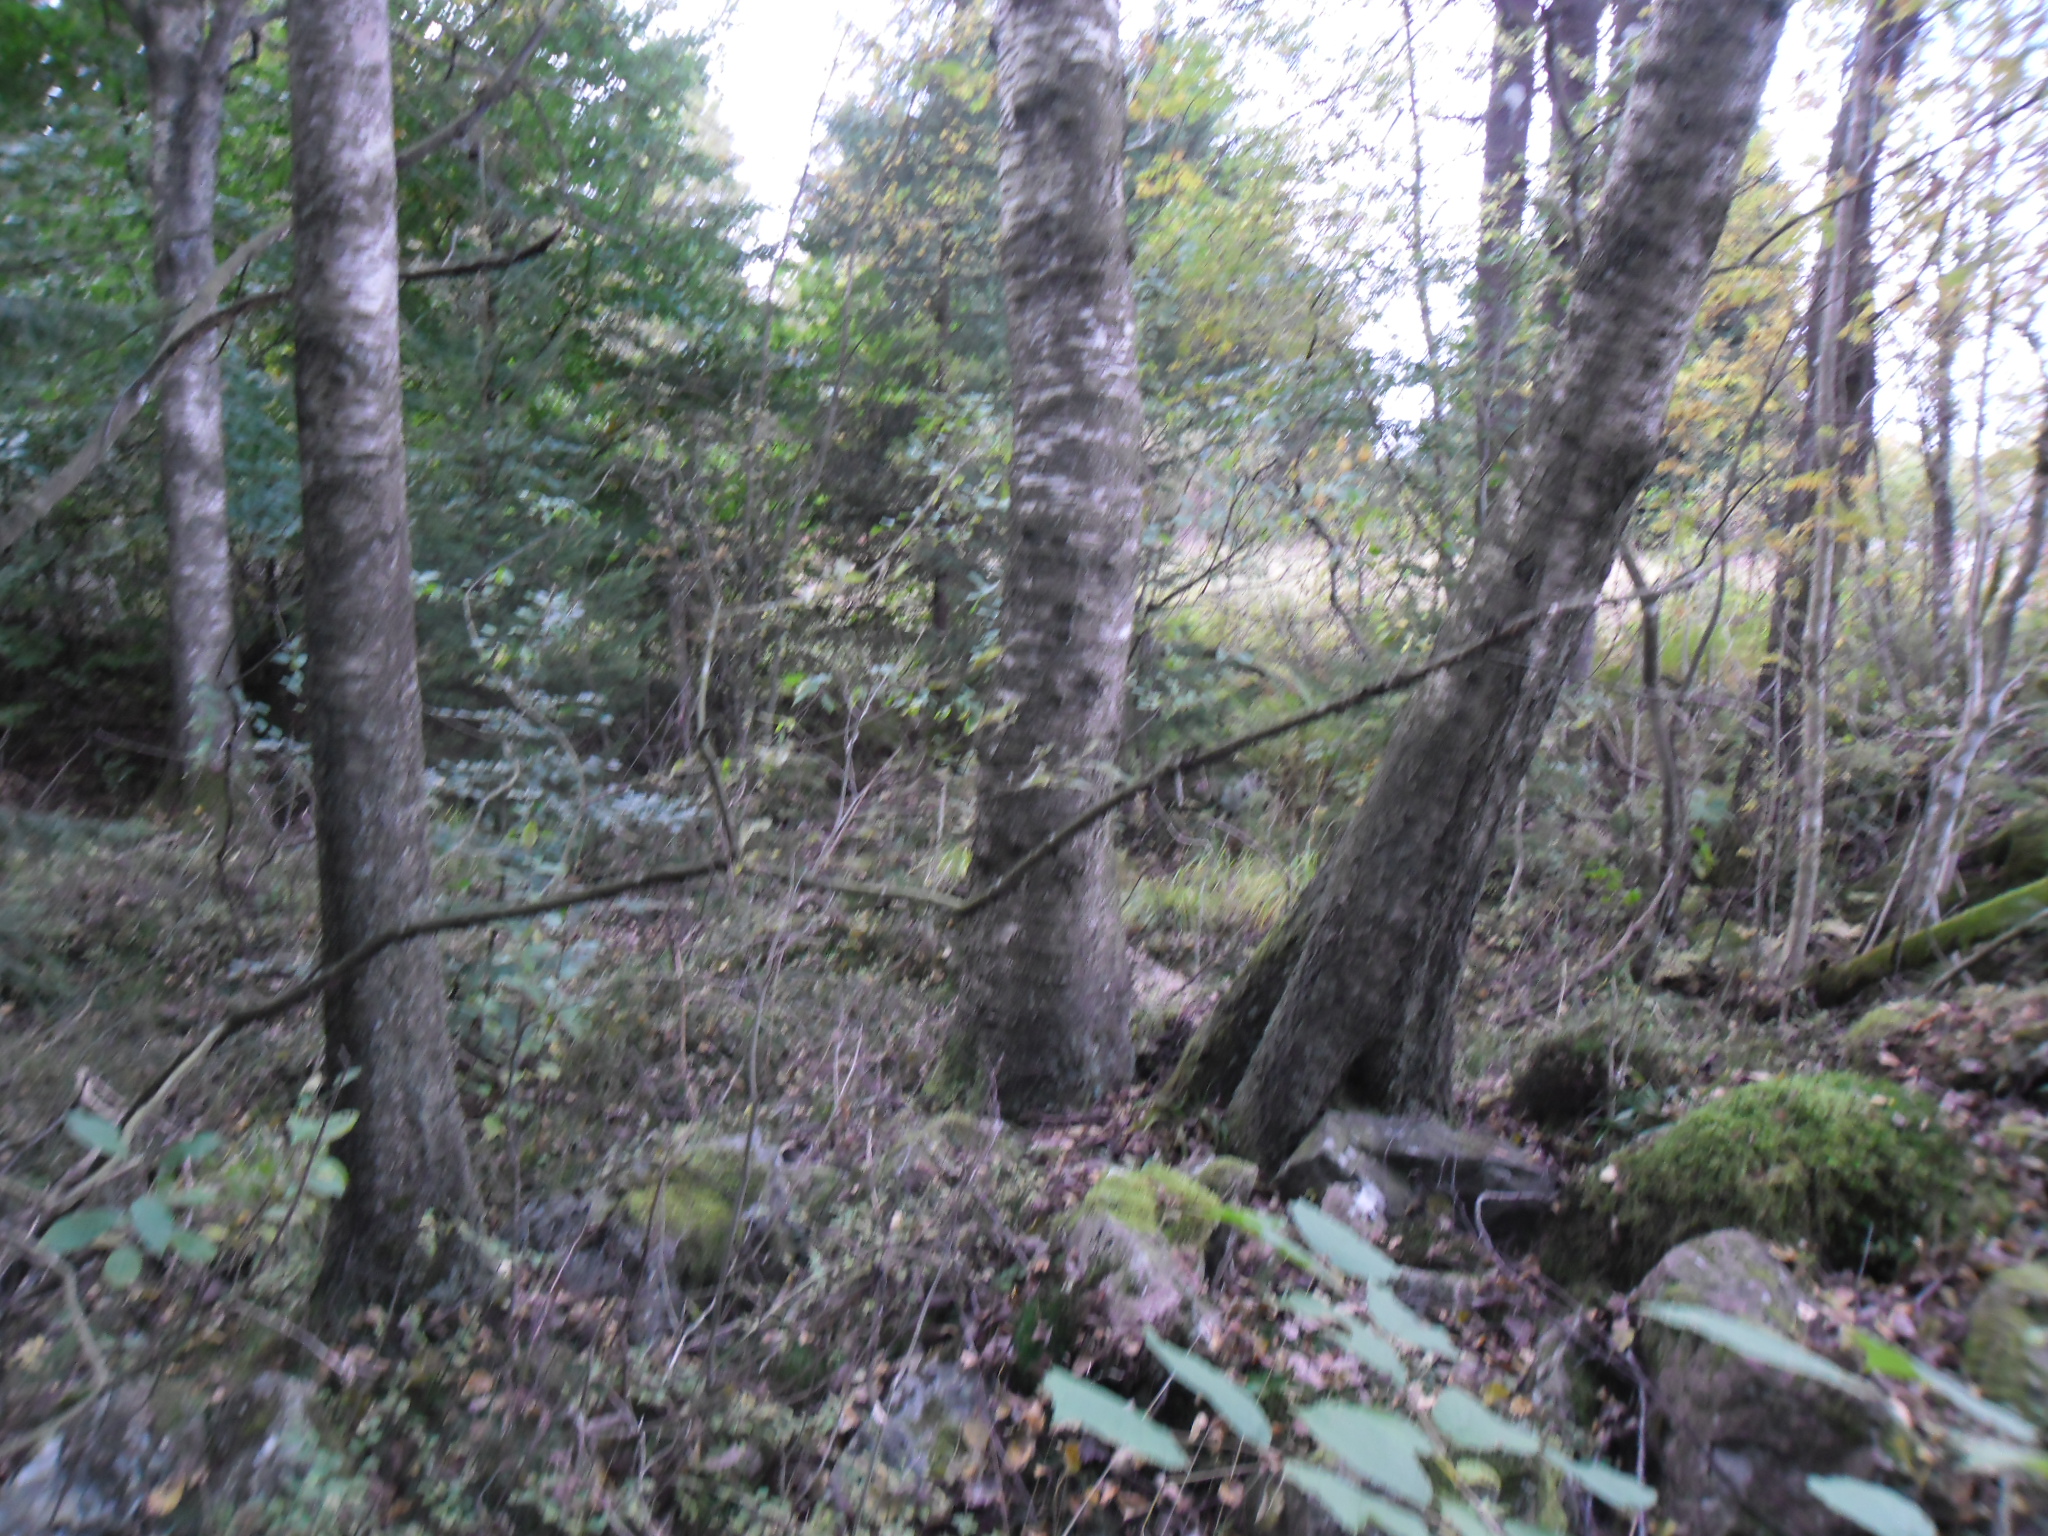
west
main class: Woodland
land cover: Broadleaved woodland
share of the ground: > 75 %
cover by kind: broadleaved forest trees 85 %, shrubs 15 %
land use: Forestry
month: October
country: SE
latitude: 56.6335
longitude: 13.2085
